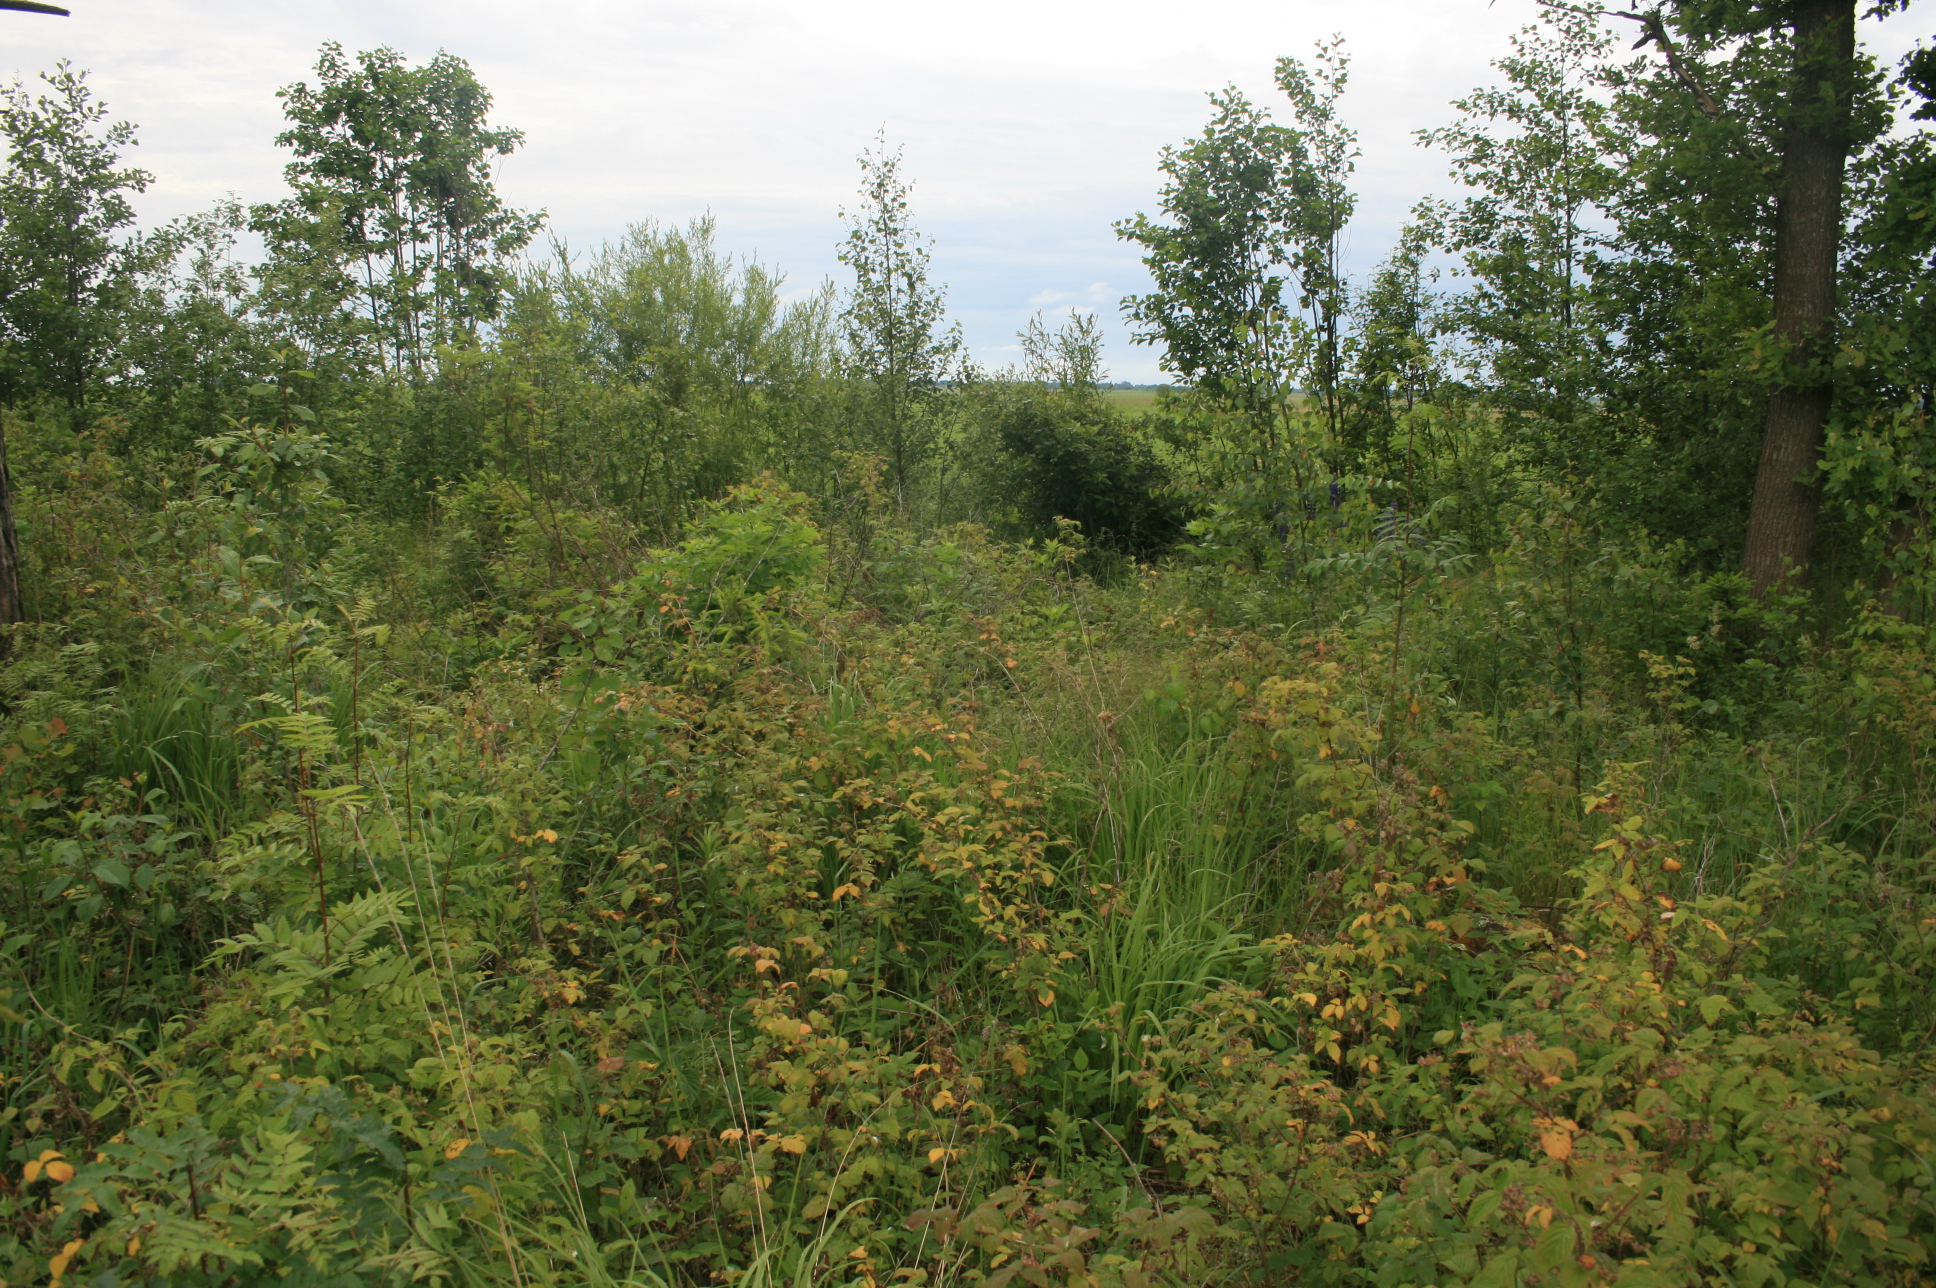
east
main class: Woodland
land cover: Broadleaved woodland
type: non-riverine alder, birch or aspen forest
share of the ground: 25 - 50 %
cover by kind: shrubs 50 %, broadleaved forest trees 30 %, coniferous forest trees 10 %, herbaceous plants 10 %
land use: Forestry
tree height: < 5 m
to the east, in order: Broadleaved woodland; Ditches and canals; Abandoned hedges; Tracks; Grass margins; Electric lines; Grassland without tree/shrub cover
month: June
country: LT
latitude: 55.2289
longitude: 22.1150
